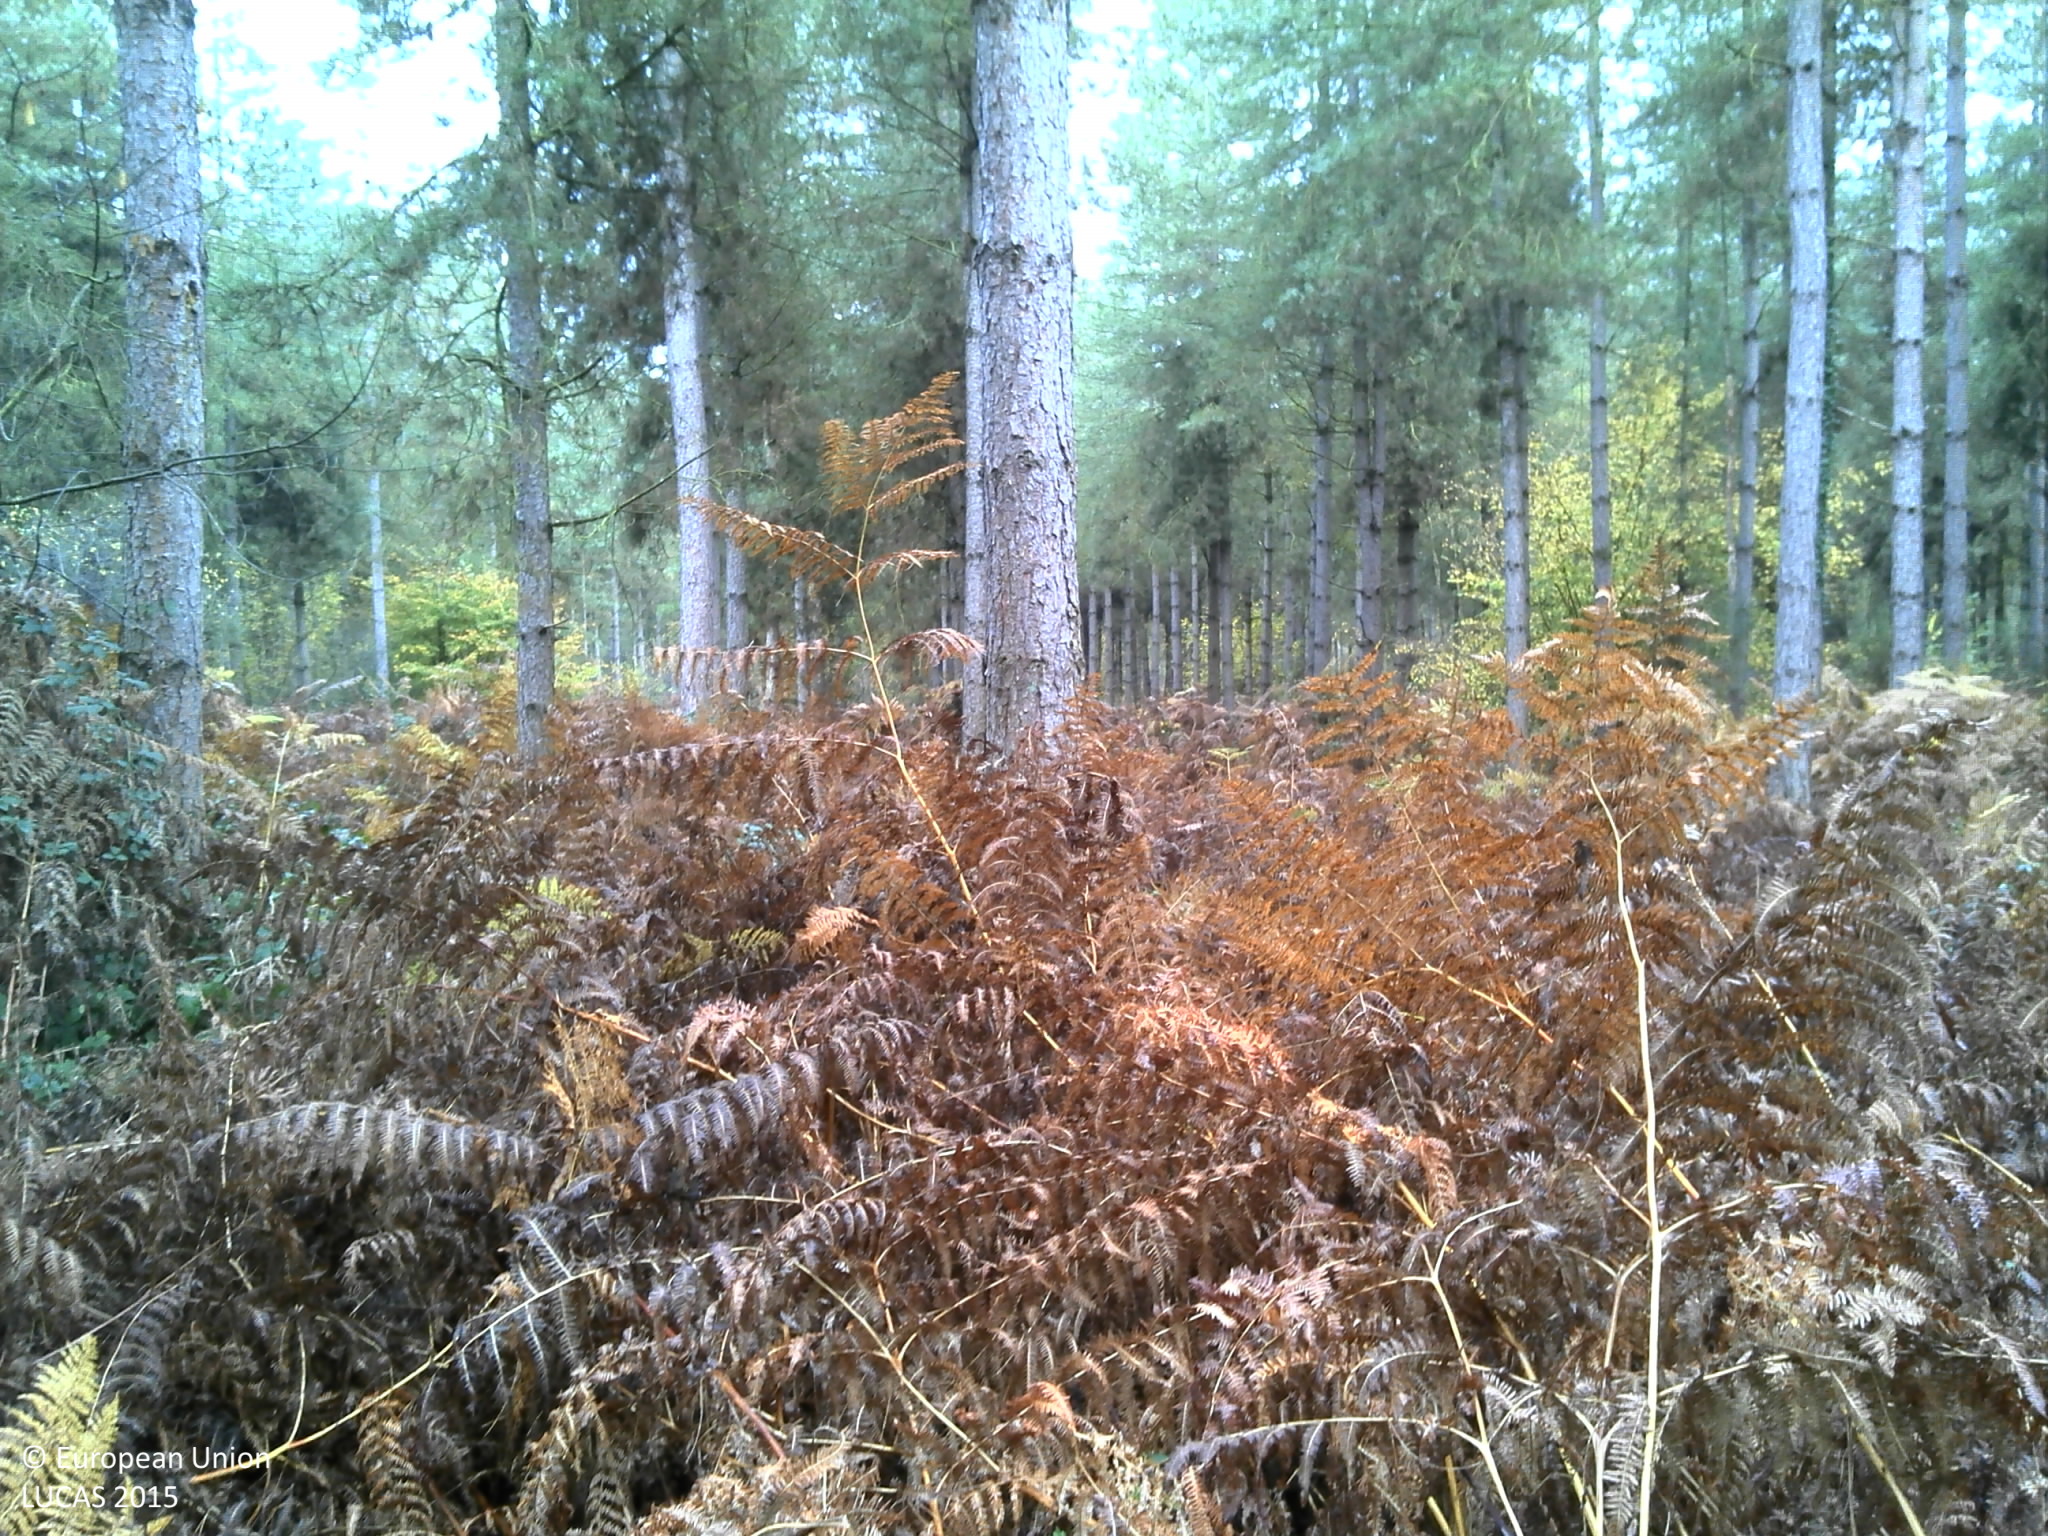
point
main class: Woodland
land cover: Pine dominated coniferous woodland
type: exotic forest
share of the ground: > 75 %
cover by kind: coniferous forest trees 85 %, herbaceous plants 15 %
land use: Forestry
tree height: > 5 m
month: November
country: FR
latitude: 47.6878
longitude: -1.5417
